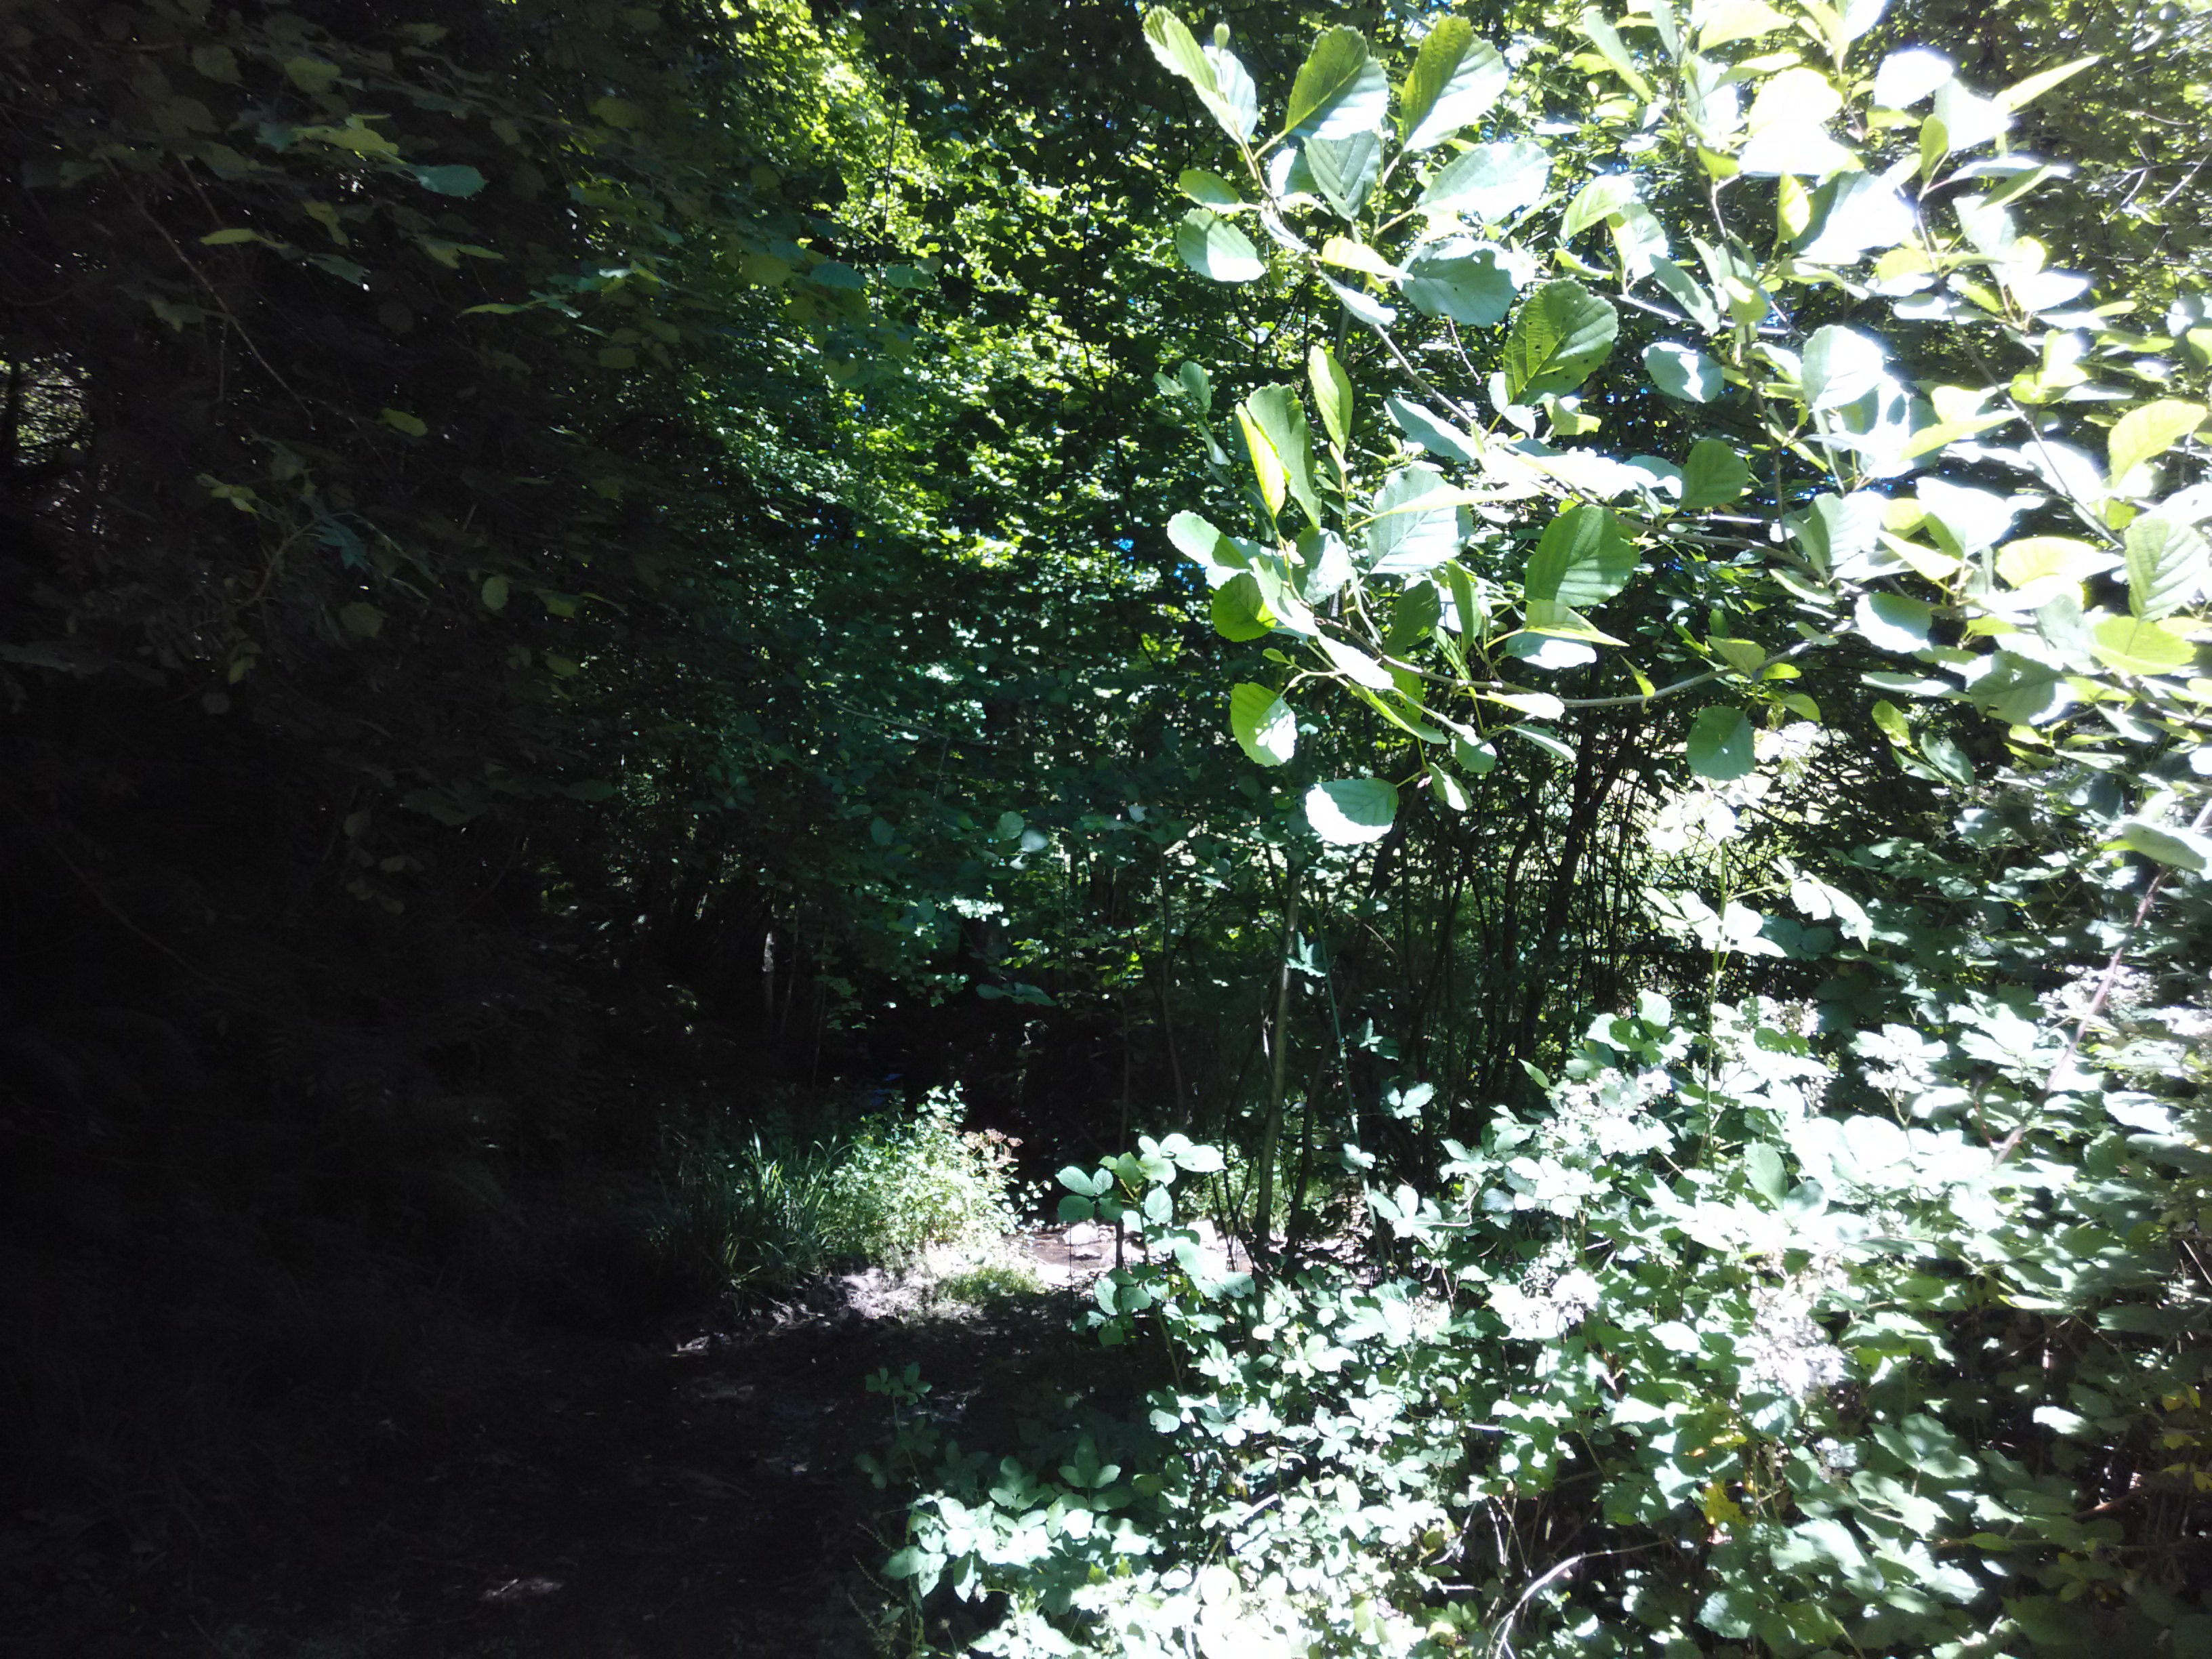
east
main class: Woodland
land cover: Other mixed woodland
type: thermophilous deciduous forest
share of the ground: > 75 %
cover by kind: broadleaved forest trees 60 %, coniferous forest trees 40 %
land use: Forestry
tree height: > 5 m
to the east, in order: Other mixed woodland; Tracks; Broadleaved woodland; Paved roads, cycling and walking lanes; Broadleaved woodland; Pine dominated coniferous woodland
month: June
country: ES
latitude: 43.2149
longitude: -2.4478
